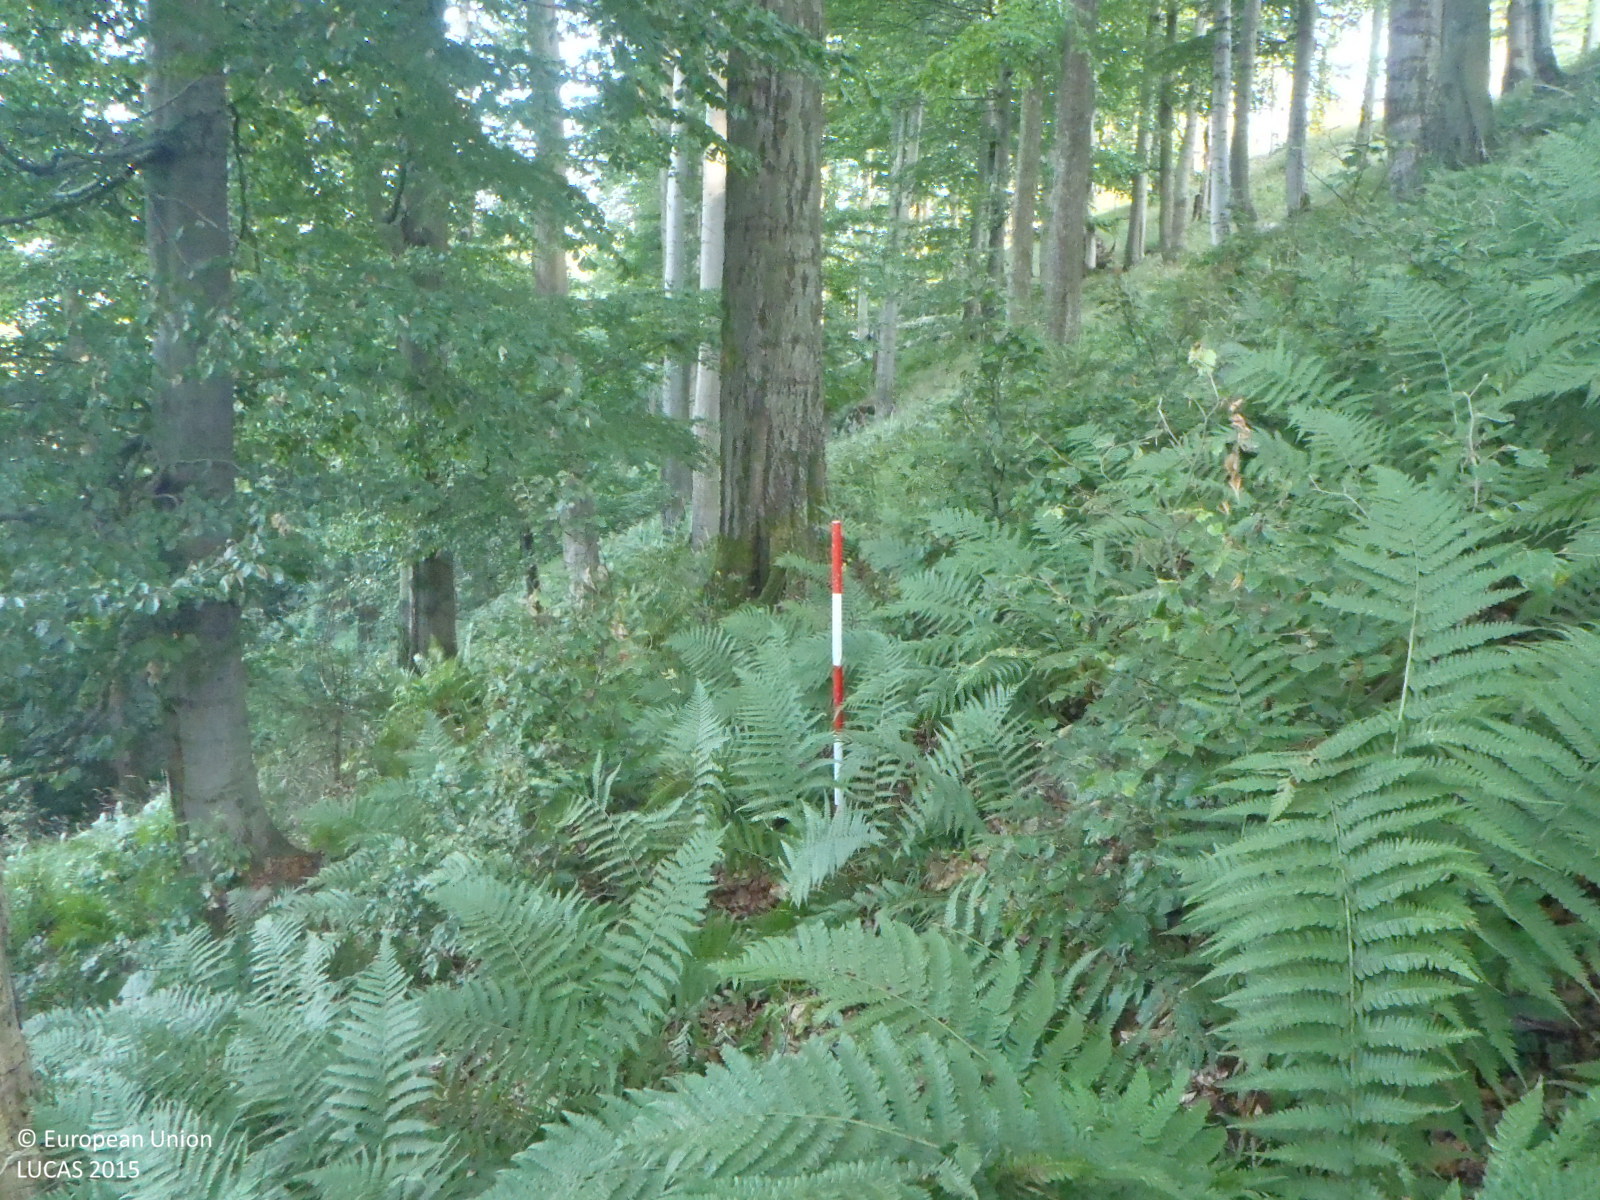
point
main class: Woodland
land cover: Broadleaved woodland
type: beech forest
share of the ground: > 75 %
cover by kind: broadleaved forest trees 95 %, herbaceous plants 5 %
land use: Forestry
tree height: > 5 m
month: August
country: CZ
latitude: 50.7956
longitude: 14.5561
